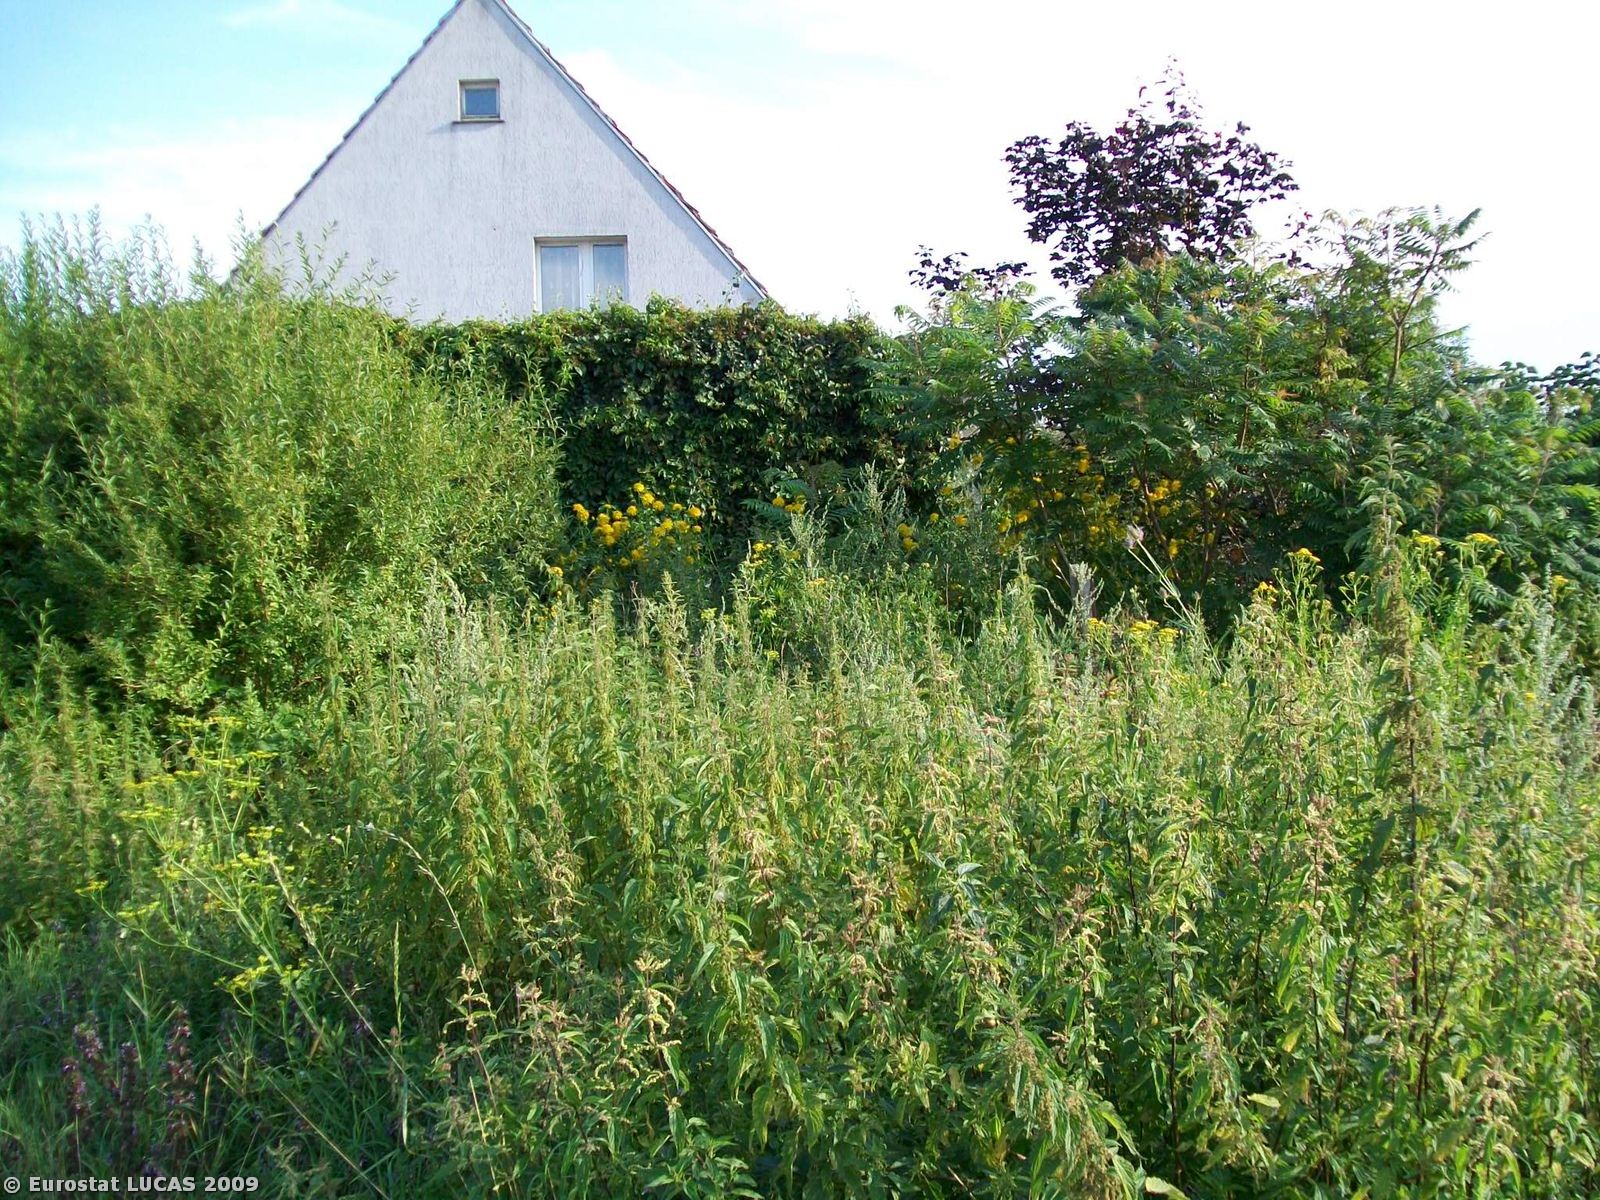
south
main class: Grassland
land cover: Spontaneously vegetated surfaces
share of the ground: > 75 %
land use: Unused
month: August
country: PL
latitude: 51.1362
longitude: 16.7977
